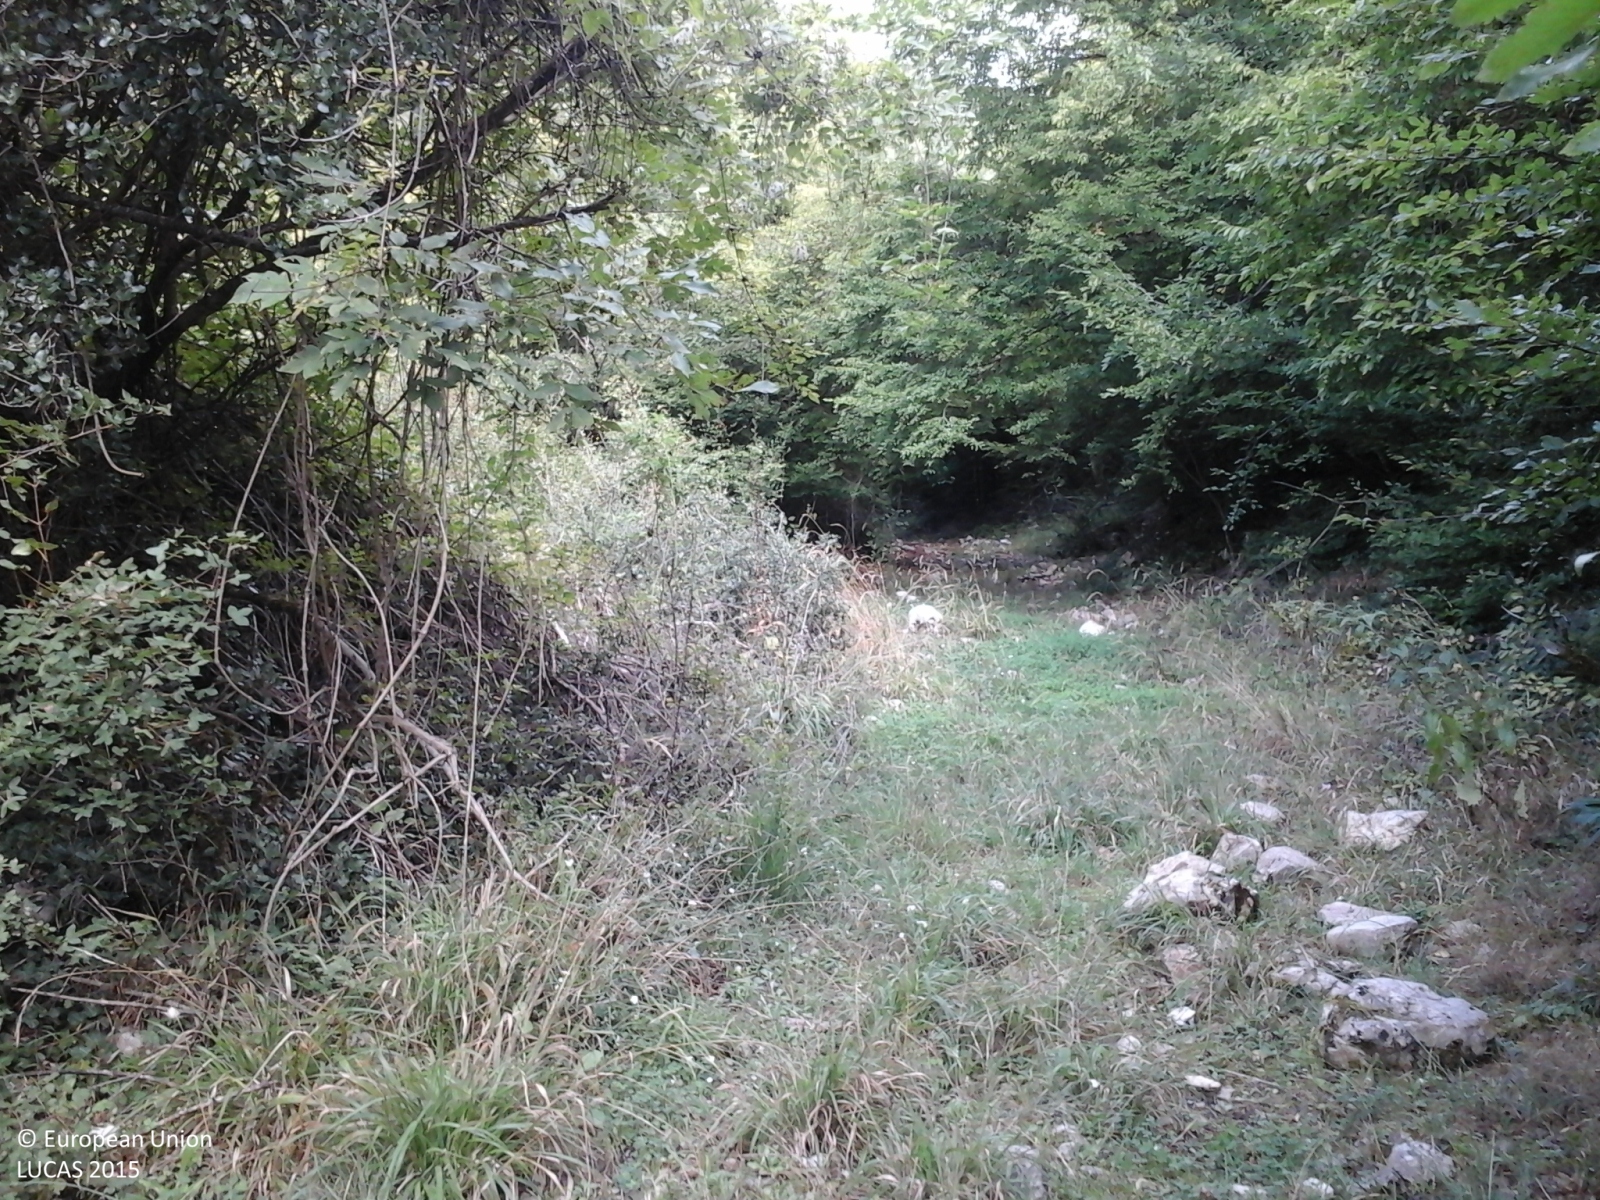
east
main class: Woodland
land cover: Broadleaved woodland
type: thermophilous deciduous forest
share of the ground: > 75 %
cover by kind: broadleaved forest trees 80 %, herbaceous plants 15 %, shrubs 5 %
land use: Forestry
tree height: > 5 m
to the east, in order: Broadleaved woodland; Rivers and streams; Broadleaved woodland
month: September
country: GR
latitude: 39.9038
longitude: 20.6591
